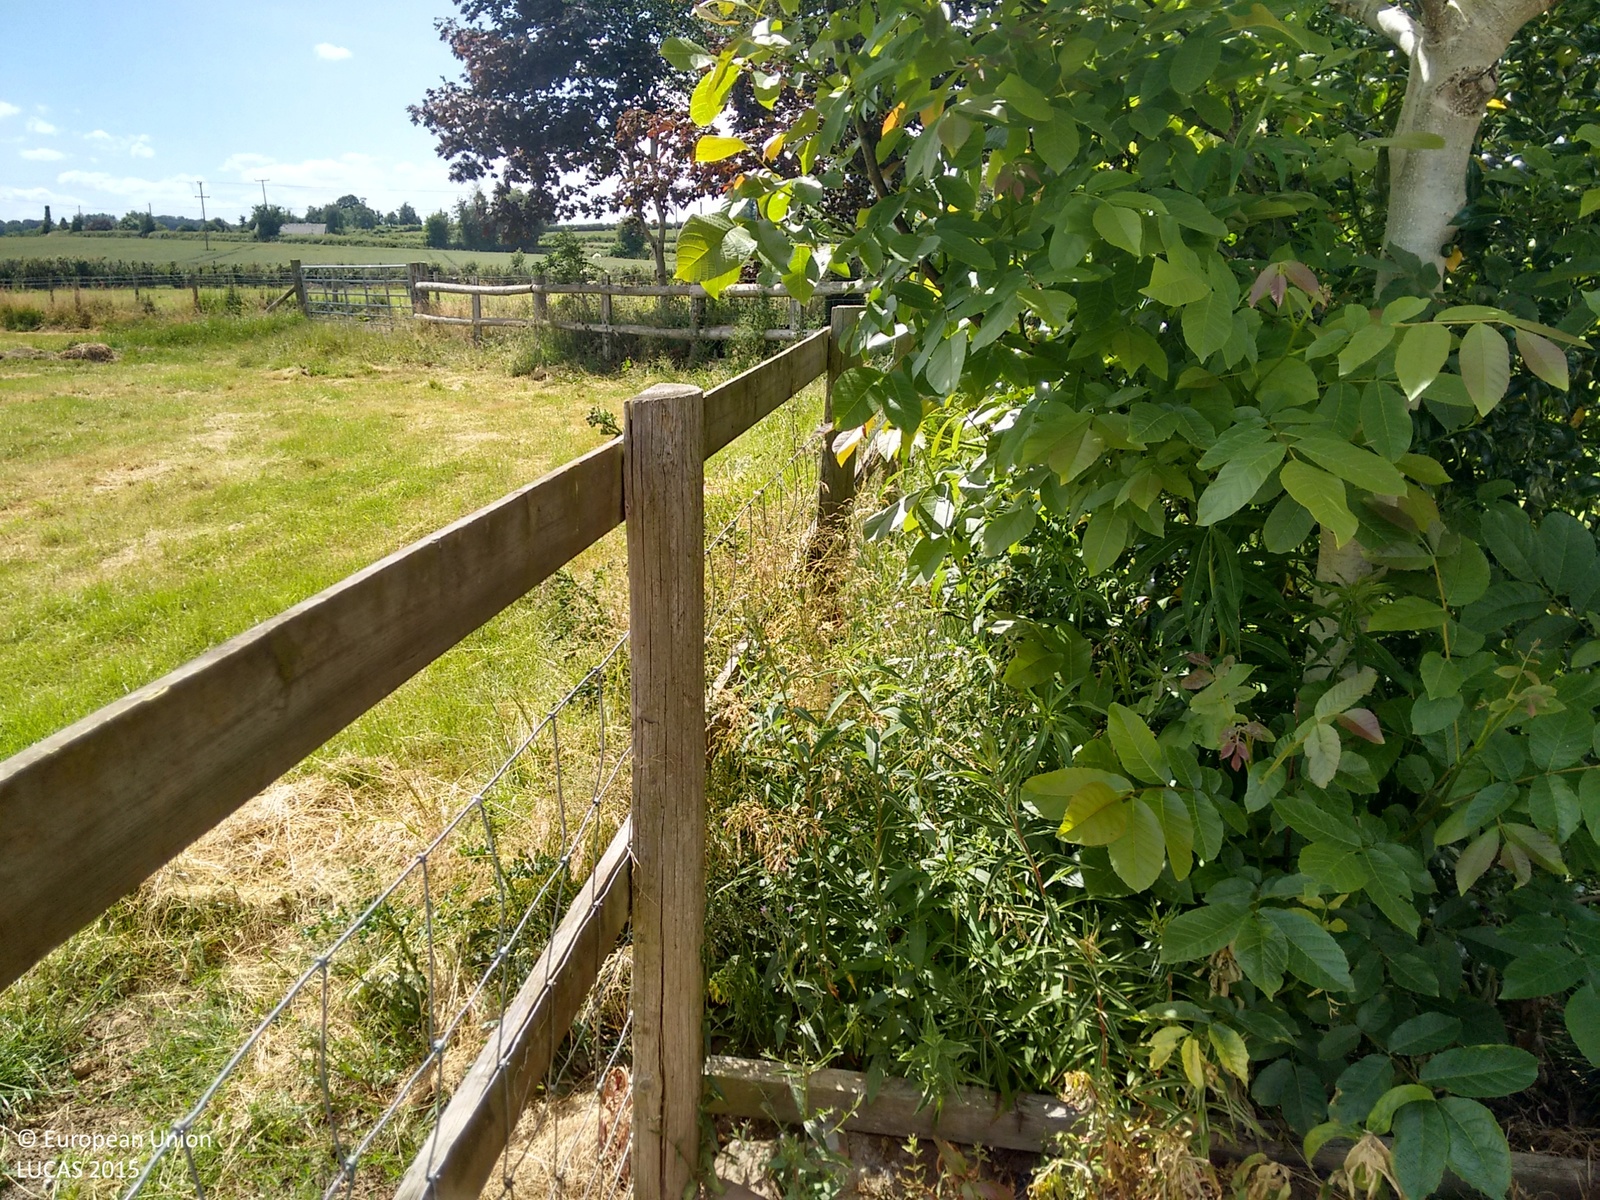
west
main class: Grassland
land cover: Grassland without tree/shrub cover
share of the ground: > 75 %
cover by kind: herbaceous plants 100 %
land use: Agriculture (excluding fallow land and kitchen gardens)
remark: Harvested field
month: June
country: GB
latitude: 52.2695
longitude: -2.7464
